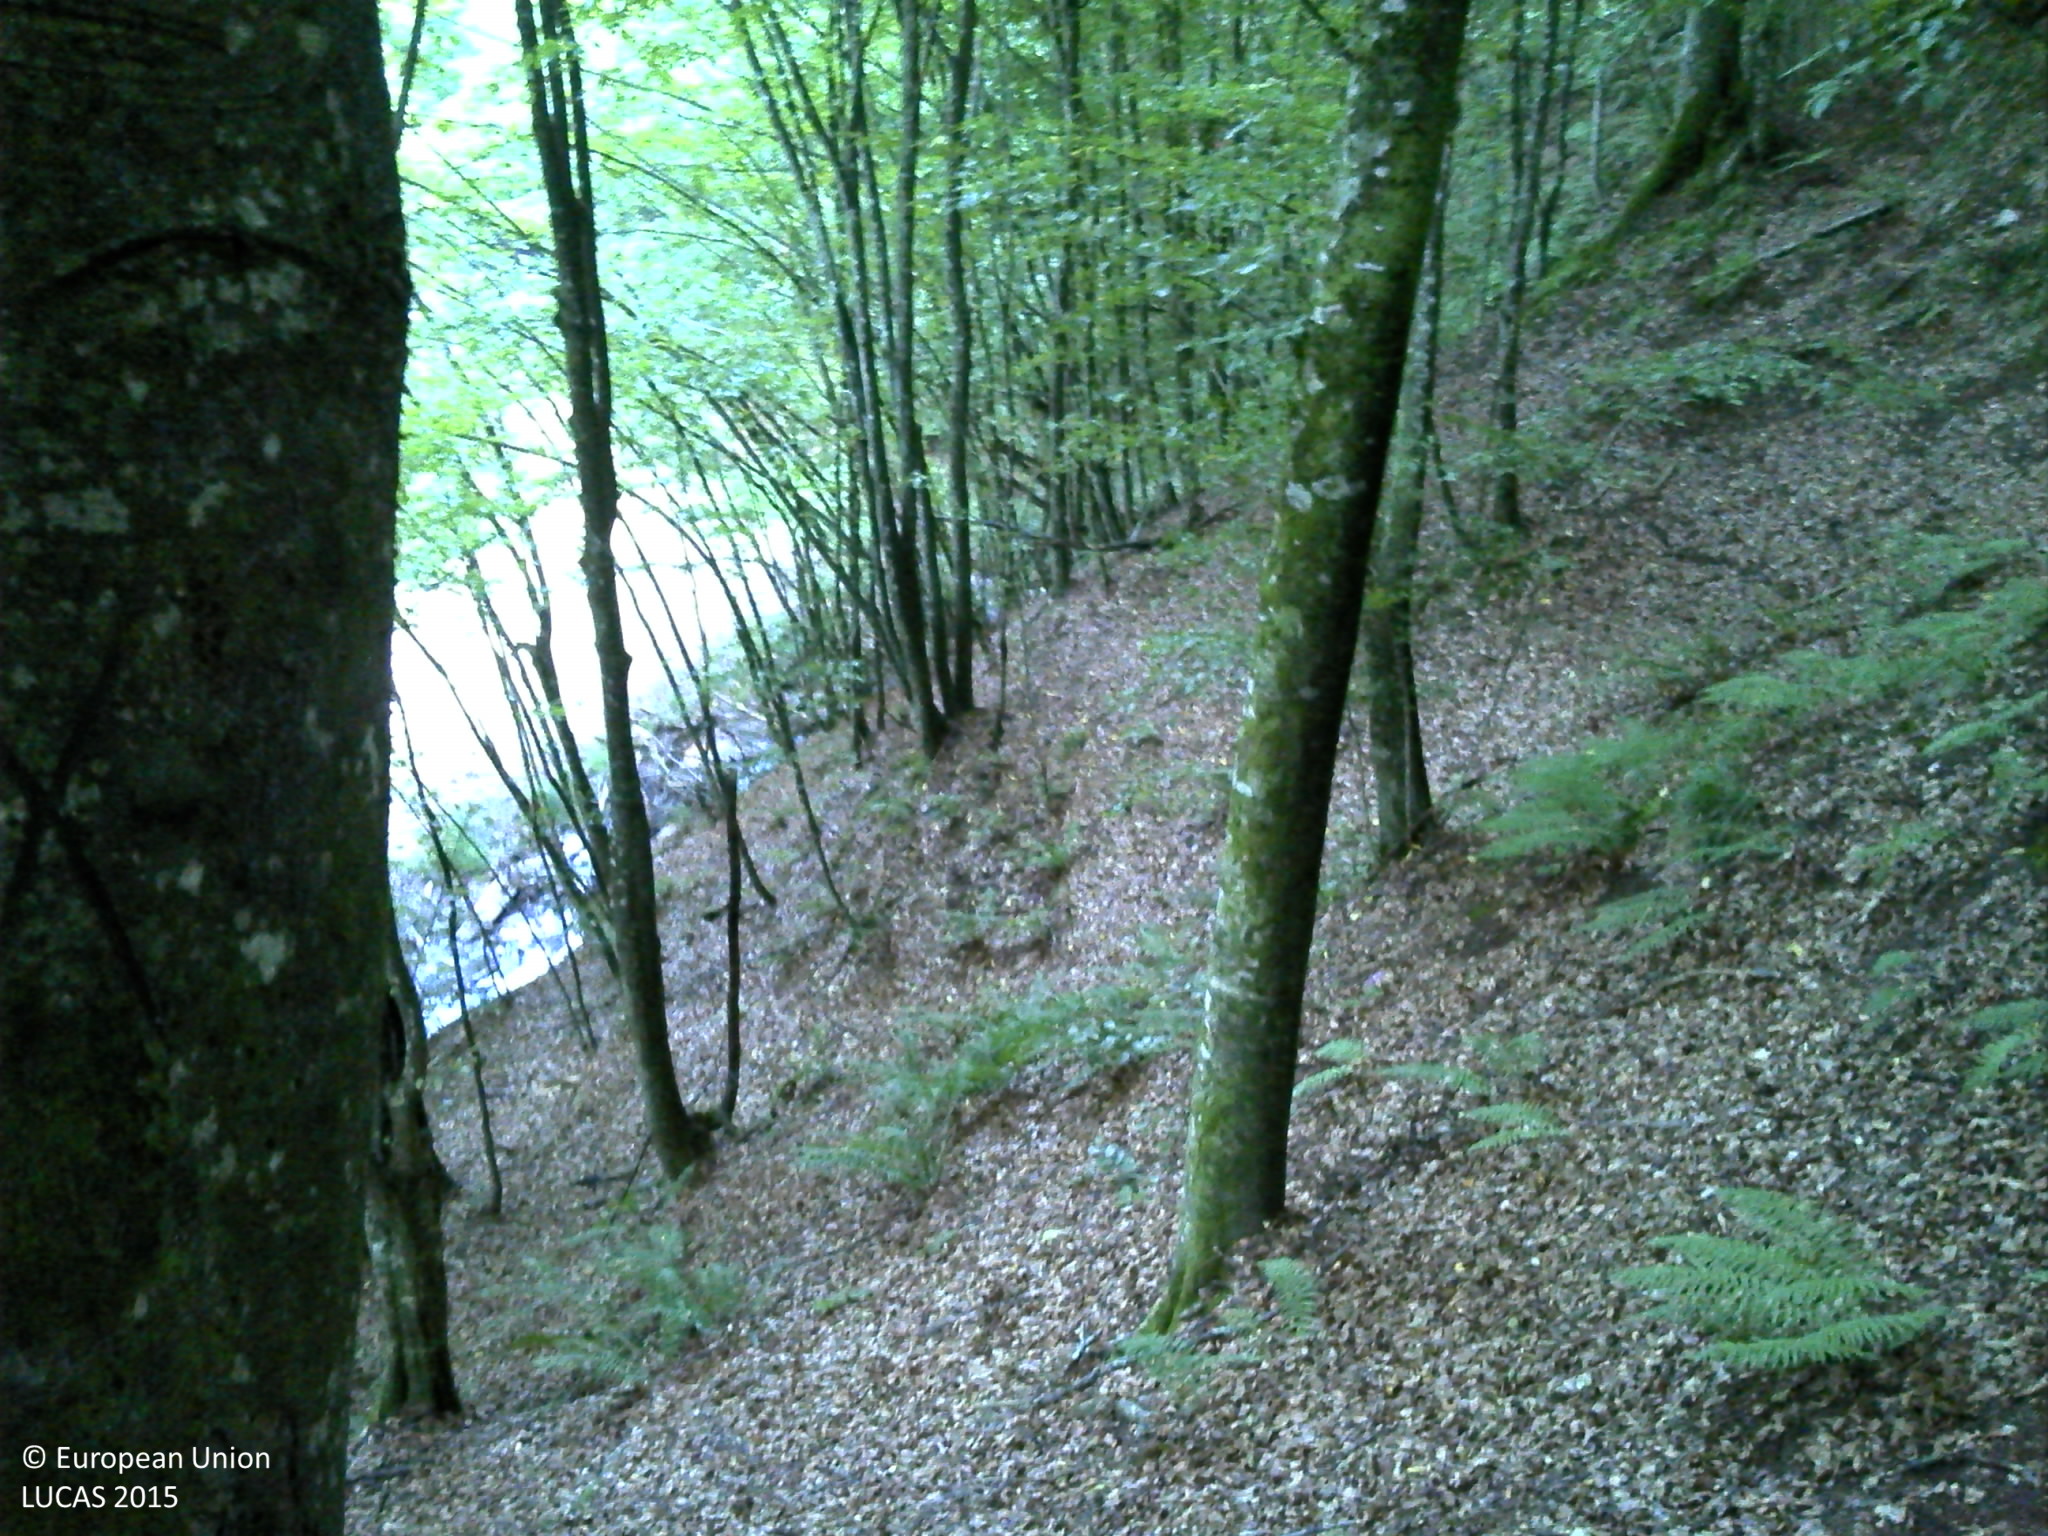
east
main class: Woodland
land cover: Broadleaved woodland
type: beech forest
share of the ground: > 75 %
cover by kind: broadleaved forest trees 100 %
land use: Forestry
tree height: > 5 m
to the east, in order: Broadleaved woodland; Paved roads, cycling and walking lanes; Broadleaved woodland; Paved roads, cycling and walking lanes; Broadleaved woodland
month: August
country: HR
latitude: 45.2181
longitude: 16.4279
